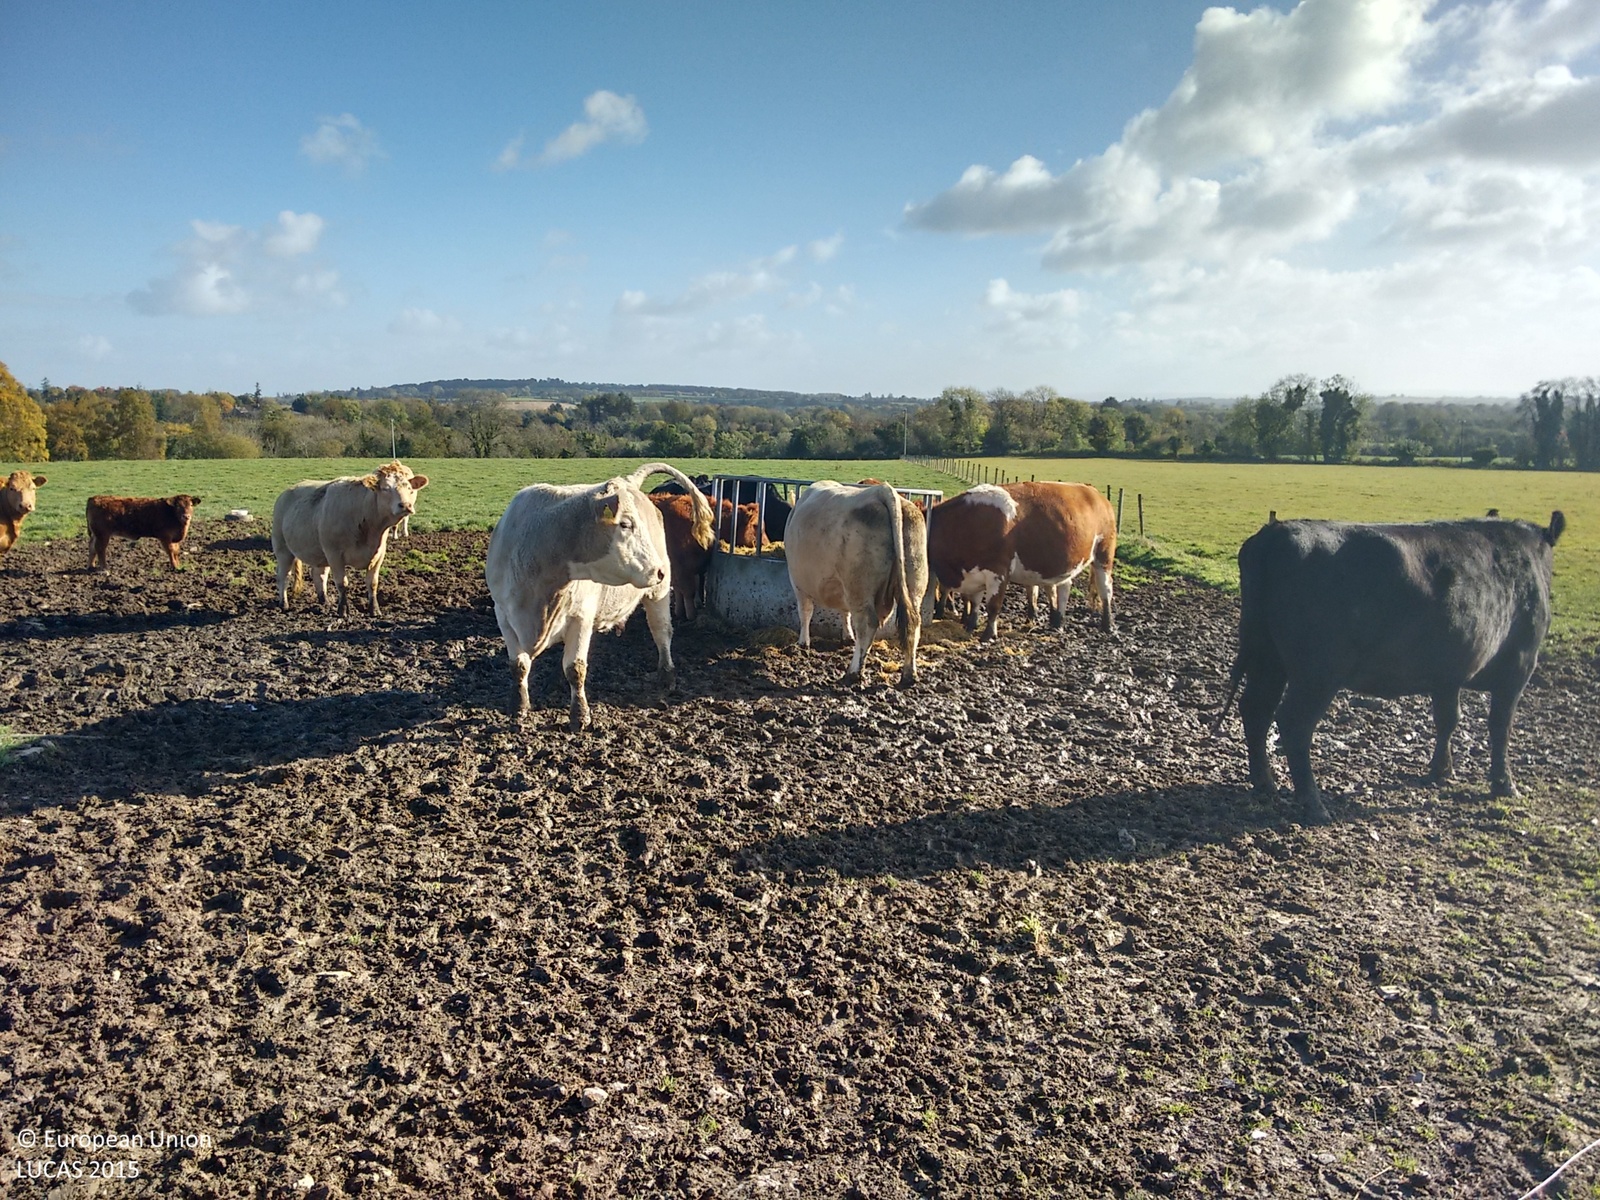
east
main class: Grassland
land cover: Grassland without tree/shrub cover
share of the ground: > 75 %
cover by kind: herbaceous plants 100 %
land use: Agriculture (excluding fallow land and kitchen gardens)
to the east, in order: Grassland without tree/shrub cover; Electric lines; Grassland without tree/shrub cover; Fences; Managed hedges; Grassland without tree/shrub cover; Broadleaved woodland; Rivers and streams; Broadleaved woodland; Grassland without tree/shrub cover
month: October
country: IE
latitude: 52.9992
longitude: -7.6106
